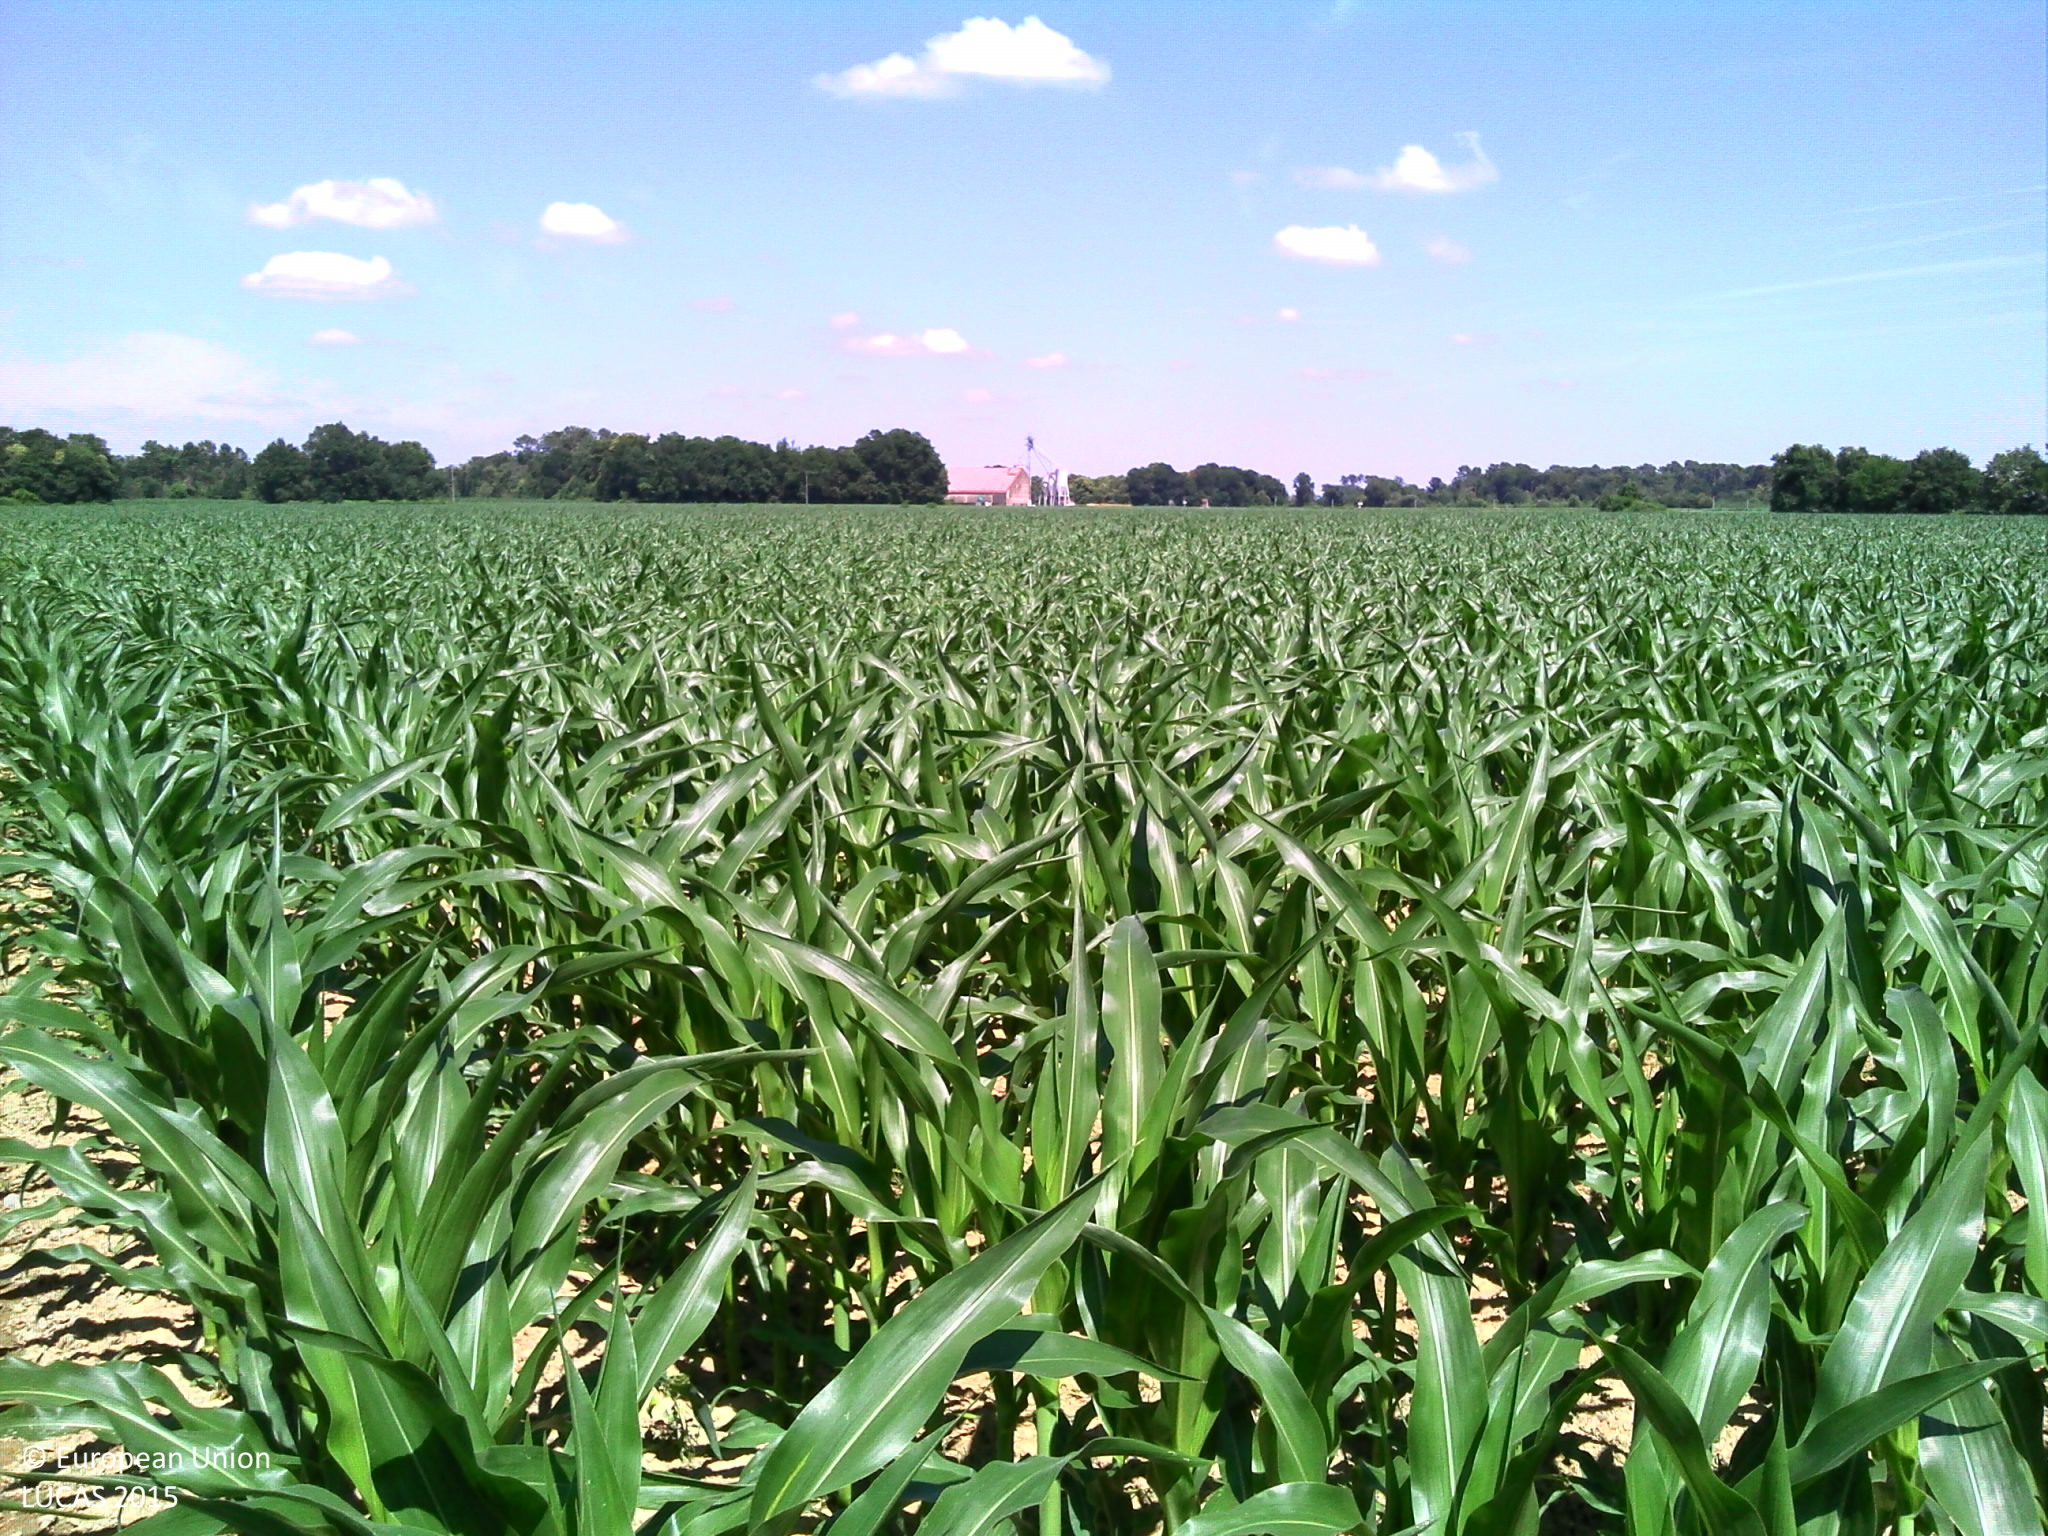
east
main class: Cropland
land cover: Maize
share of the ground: > 75 %
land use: Agriculture (excluding fallow land and kitchen gardens)
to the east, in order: Maize
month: June
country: FR
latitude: 43.6691
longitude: -0.3401
